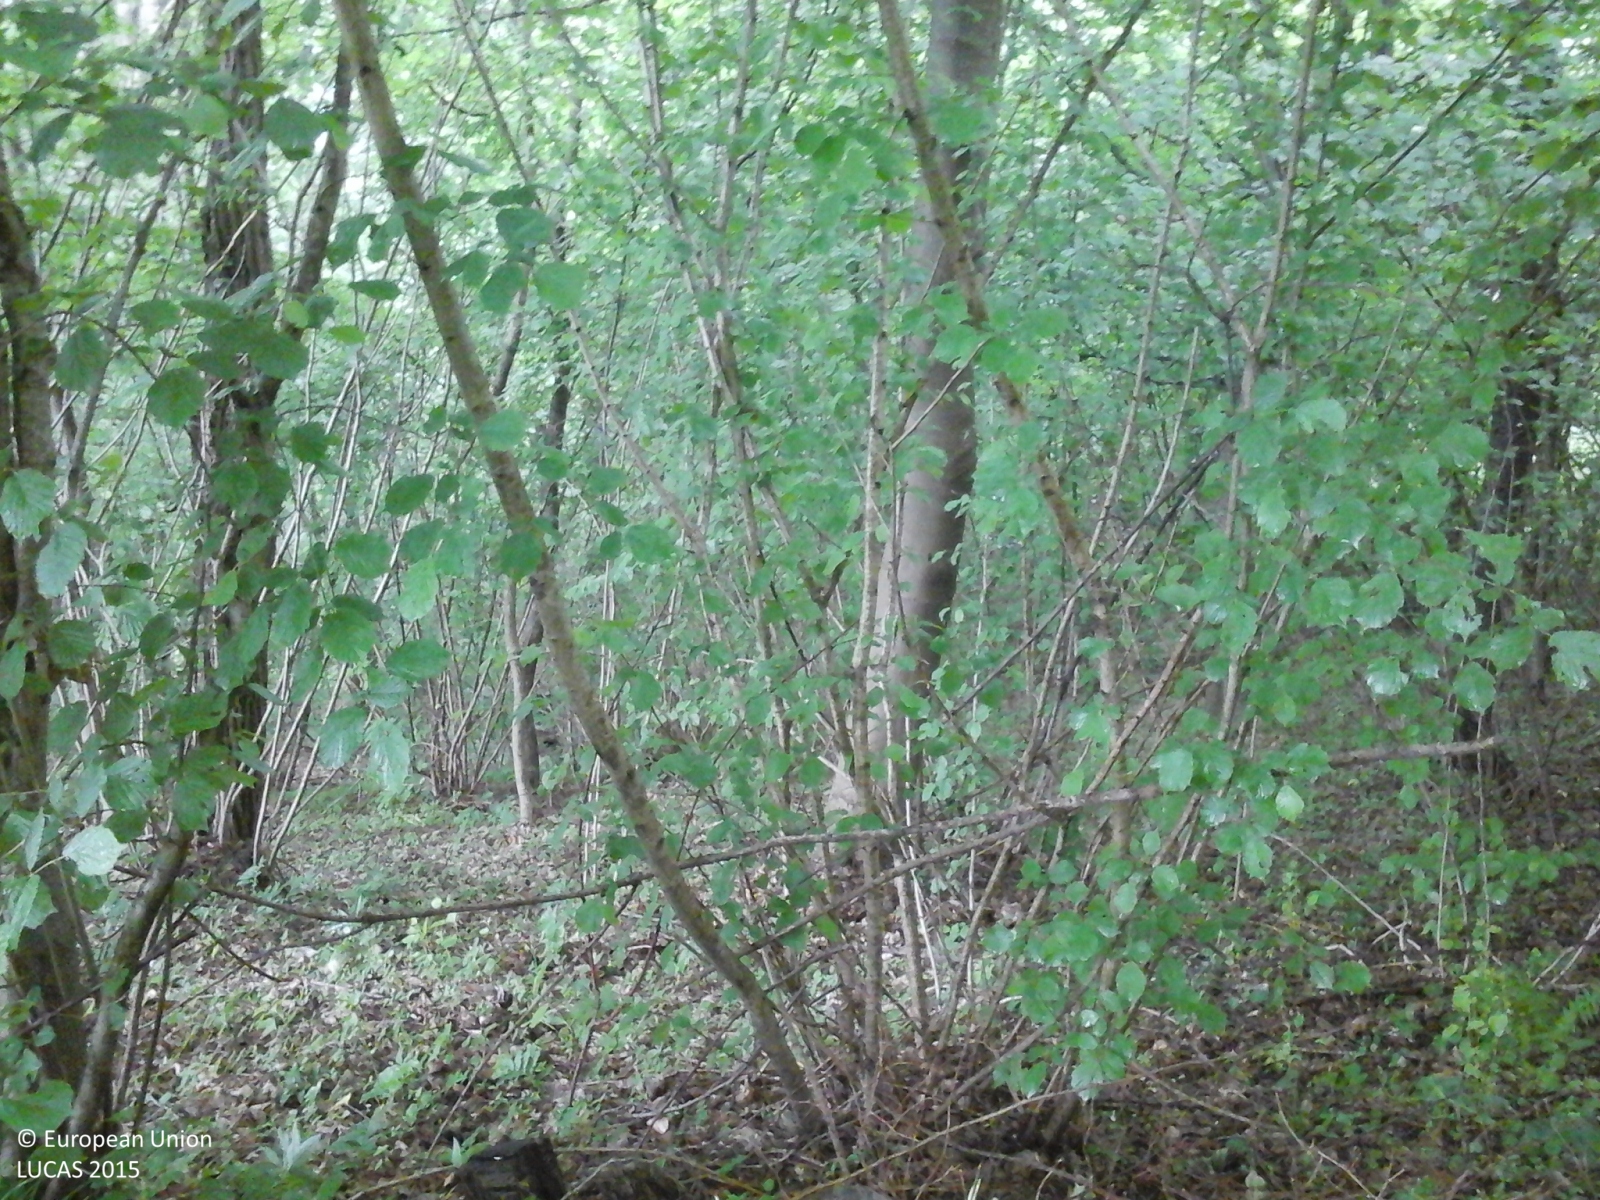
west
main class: Woodland
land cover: Broadleaved woodland
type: thermophilous deciduous forest
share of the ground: > 75 %
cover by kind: broadleaved forest trees 100 %
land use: Semi-natural and natural areas not in use
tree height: > 5 m
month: June
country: IT
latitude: 46.1268
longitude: 12.3654
